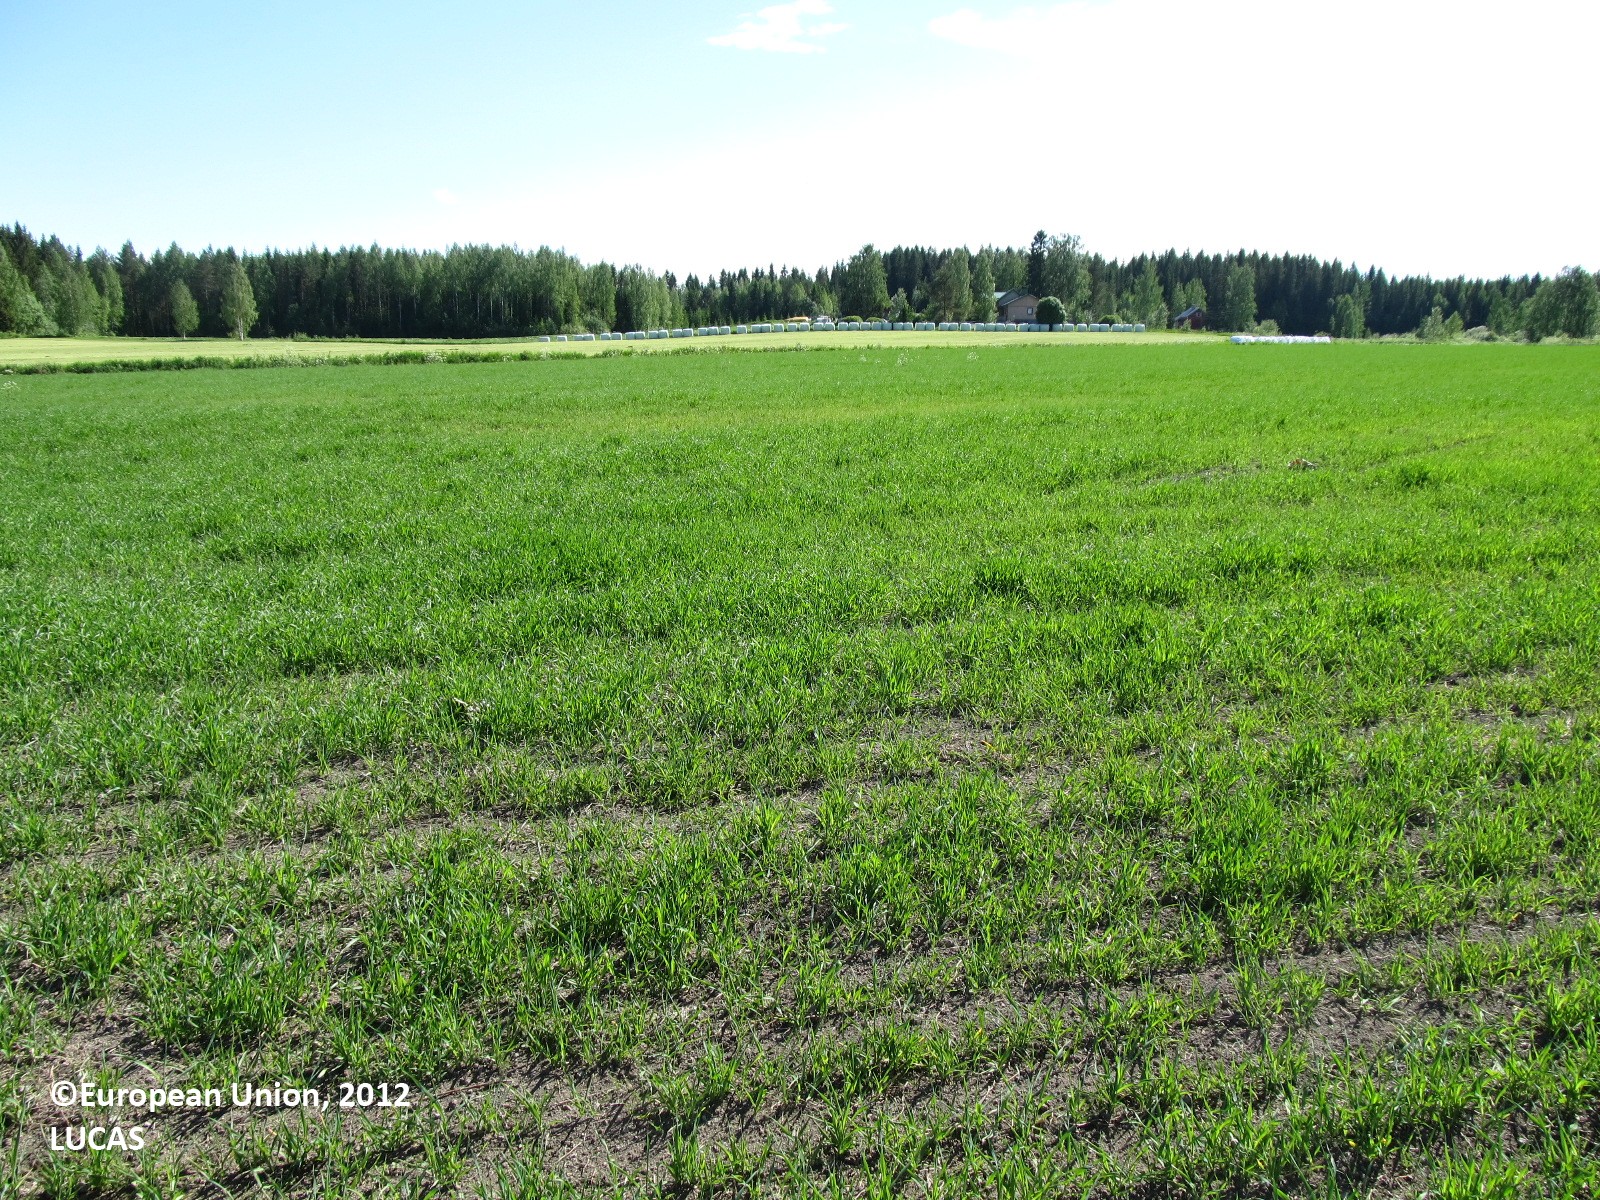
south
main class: Cropland
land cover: Barley
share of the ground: 25 - 50 %
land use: Agriculture (excluding fallow land and kitchen gardens)
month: June
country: FI
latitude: 63.0194
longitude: 27.5286
